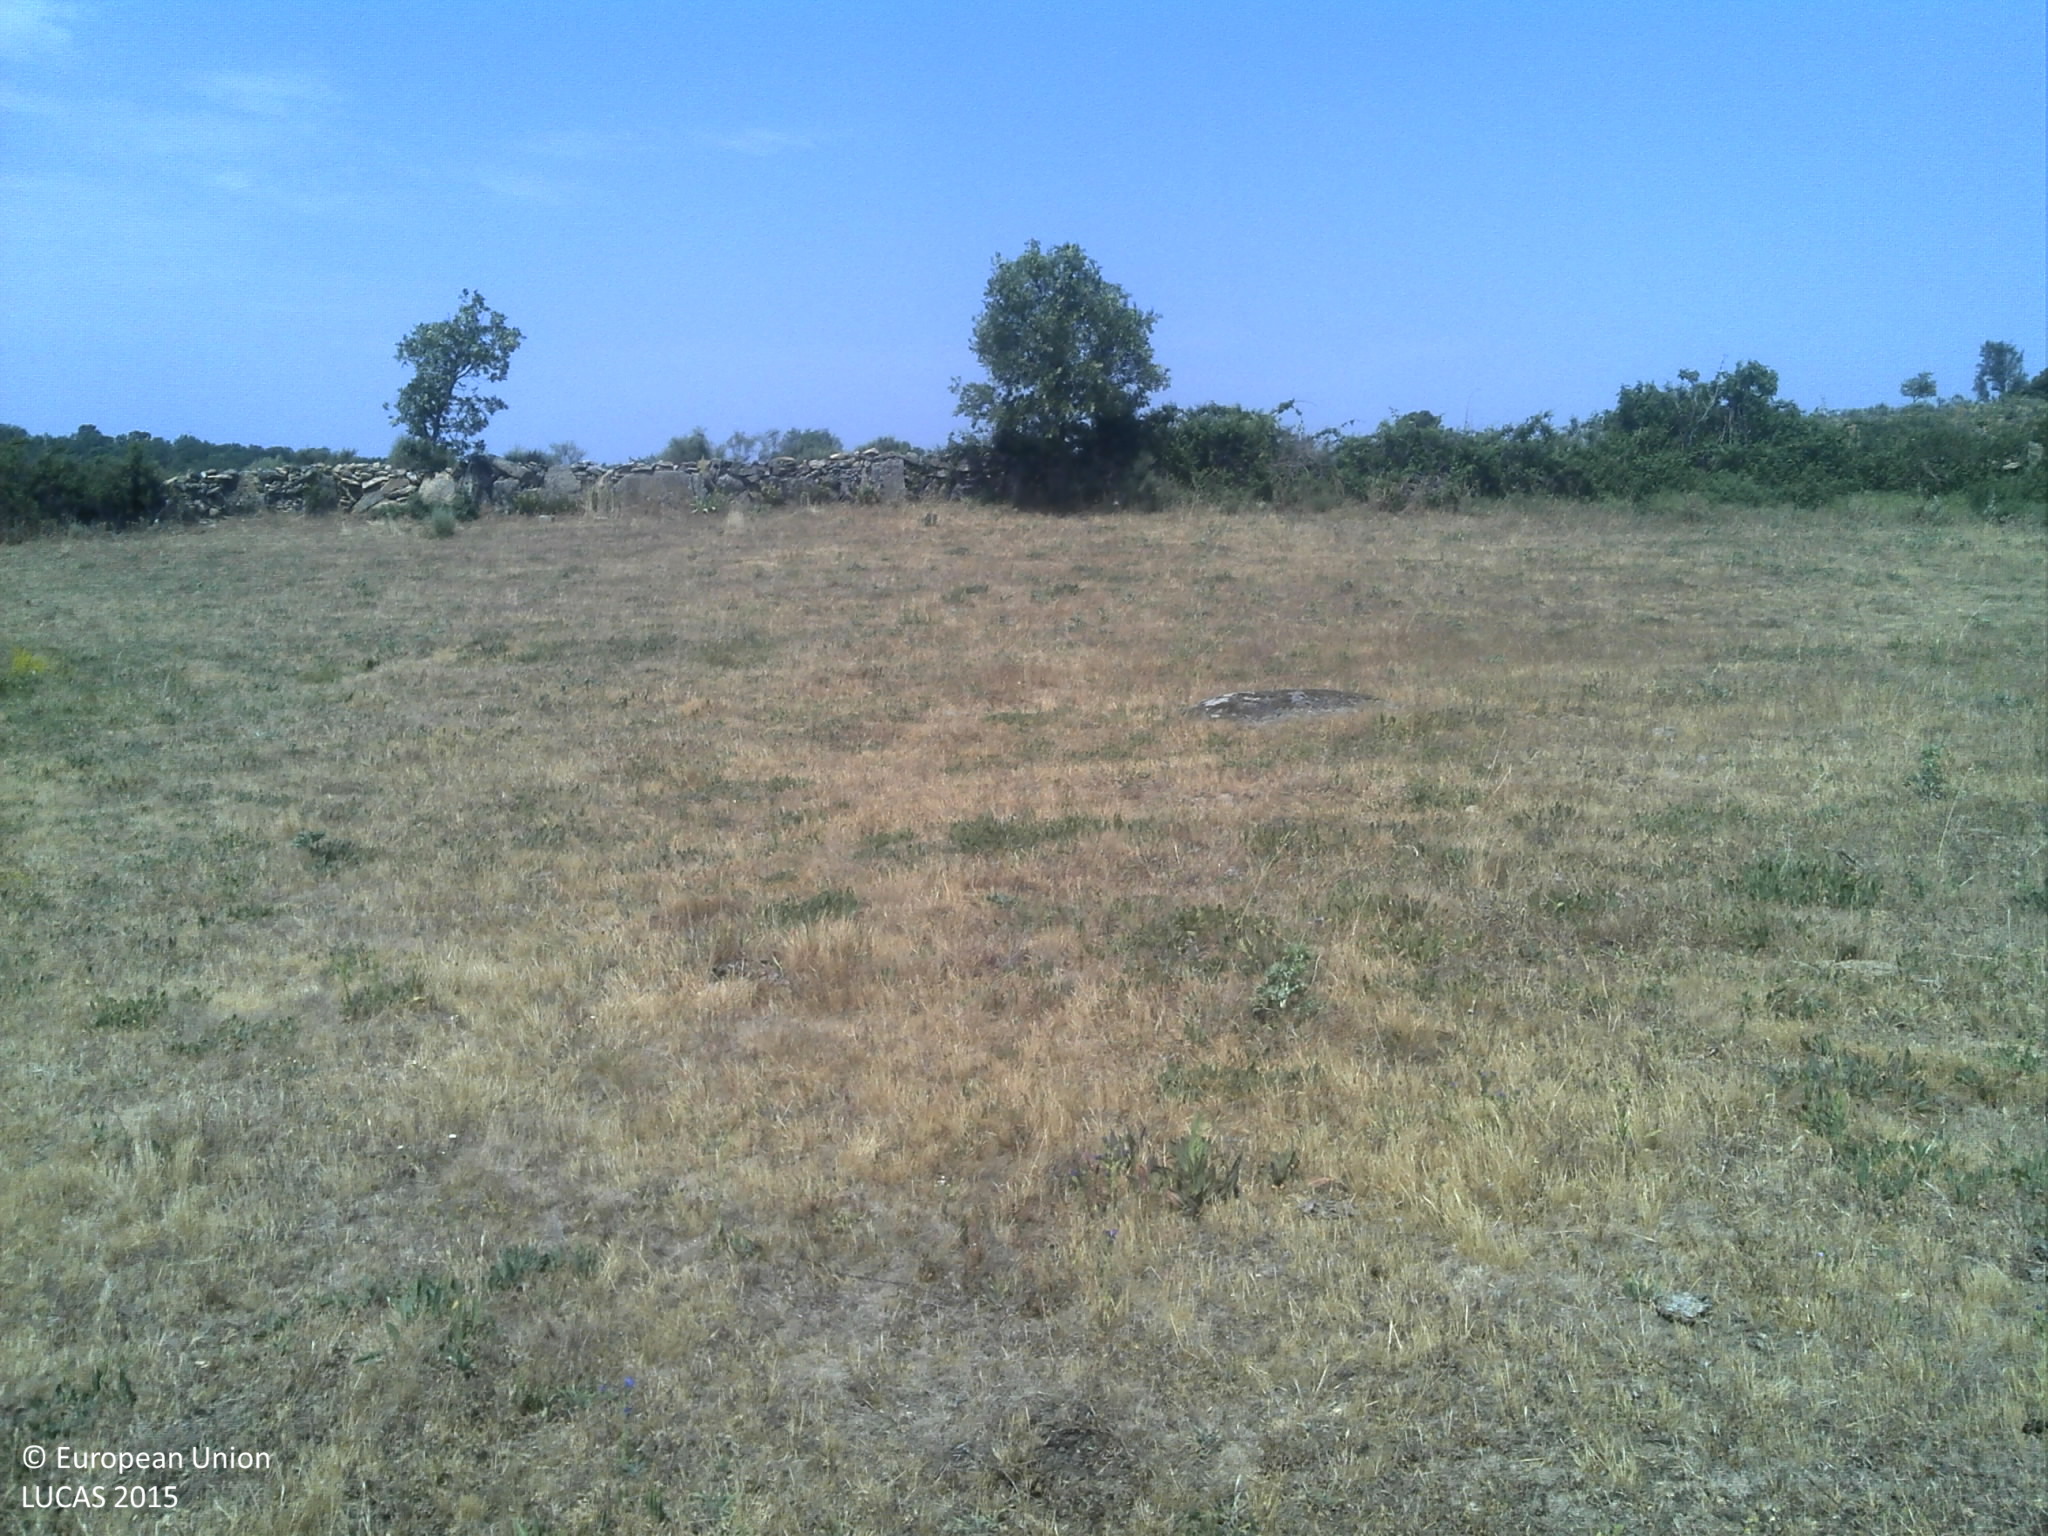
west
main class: Grassland
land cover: Grassland without tree/shrub cover
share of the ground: 50 - 75 %
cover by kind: herbaceous plants 70 %, unconsolidated bare surface 20 %
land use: Agriculture (excluding fallow land and kitchen gardens)
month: June
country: PT
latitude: 40.3998
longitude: -6.8601
